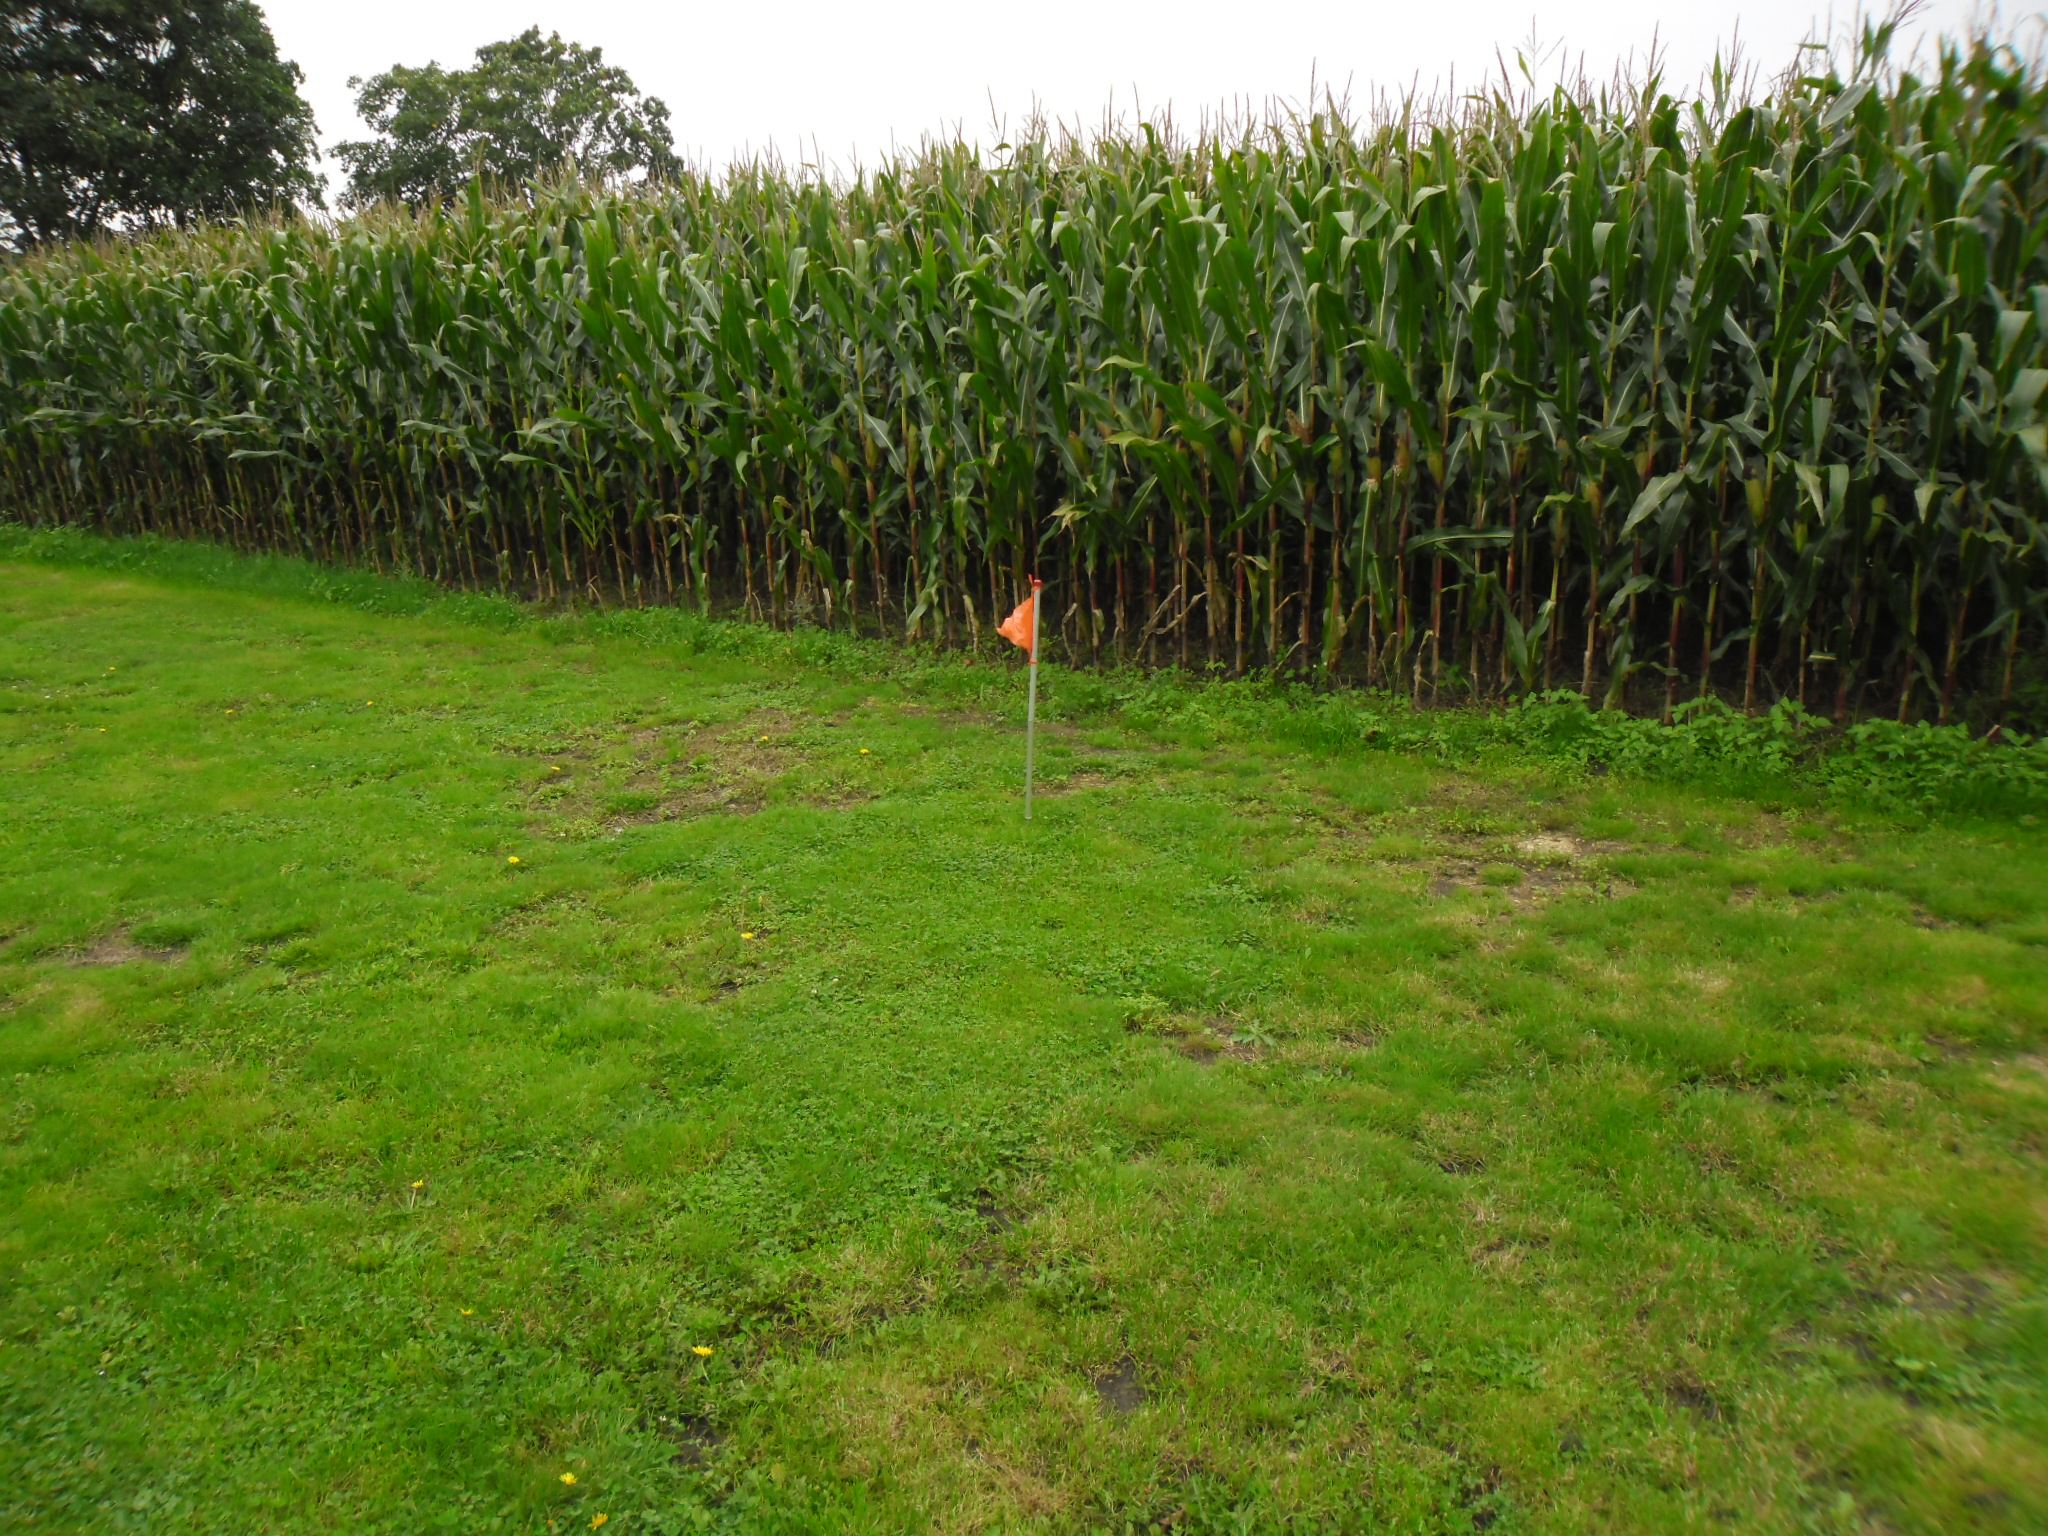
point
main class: Grassland
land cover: Grassland without tree/shrub cover
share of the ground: > 75 %
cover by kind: herbaceous plants 100 %
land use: Residential
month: September
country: NL
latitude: 52.1193
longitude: 5.6902
